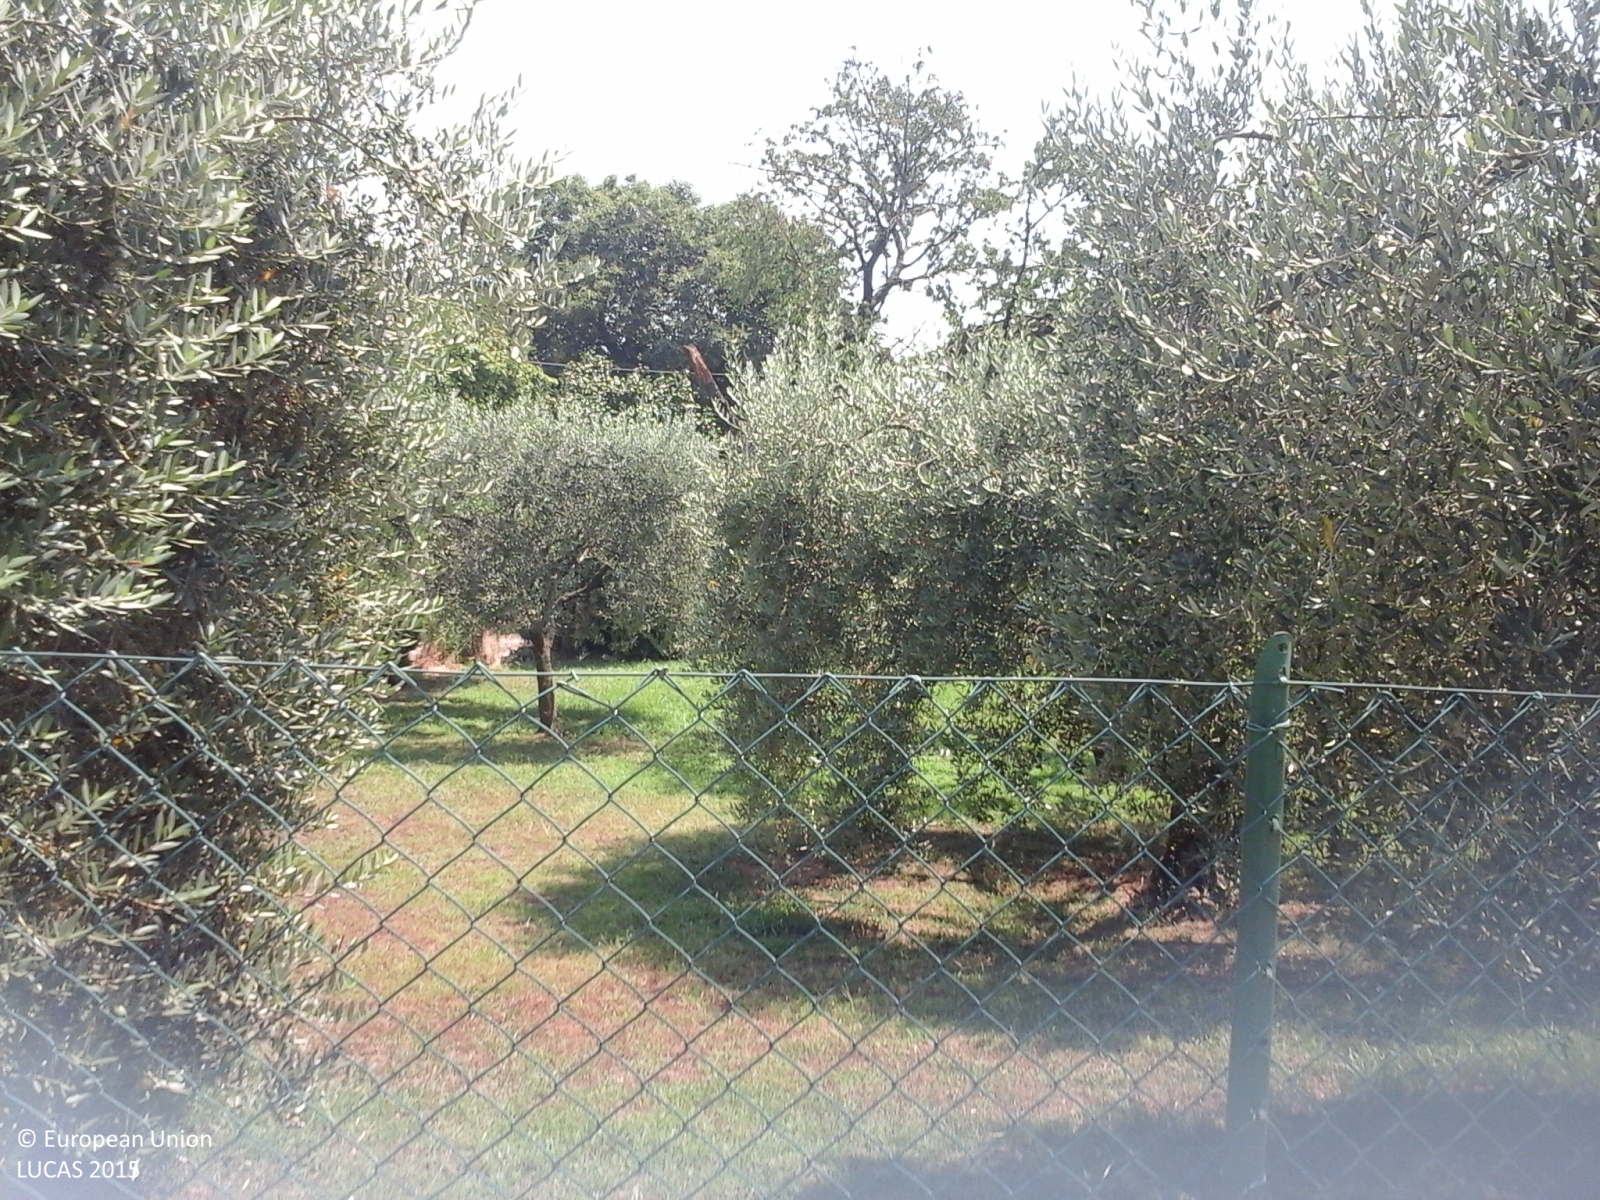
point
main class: Cropland
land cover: Olive groves
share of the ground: 50 - 75 %
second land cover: Grassland without tree/shrub cover
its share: > 75 %
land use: Kitchen garden
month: July
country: IT
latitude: 41.6930
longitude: 12.8128
